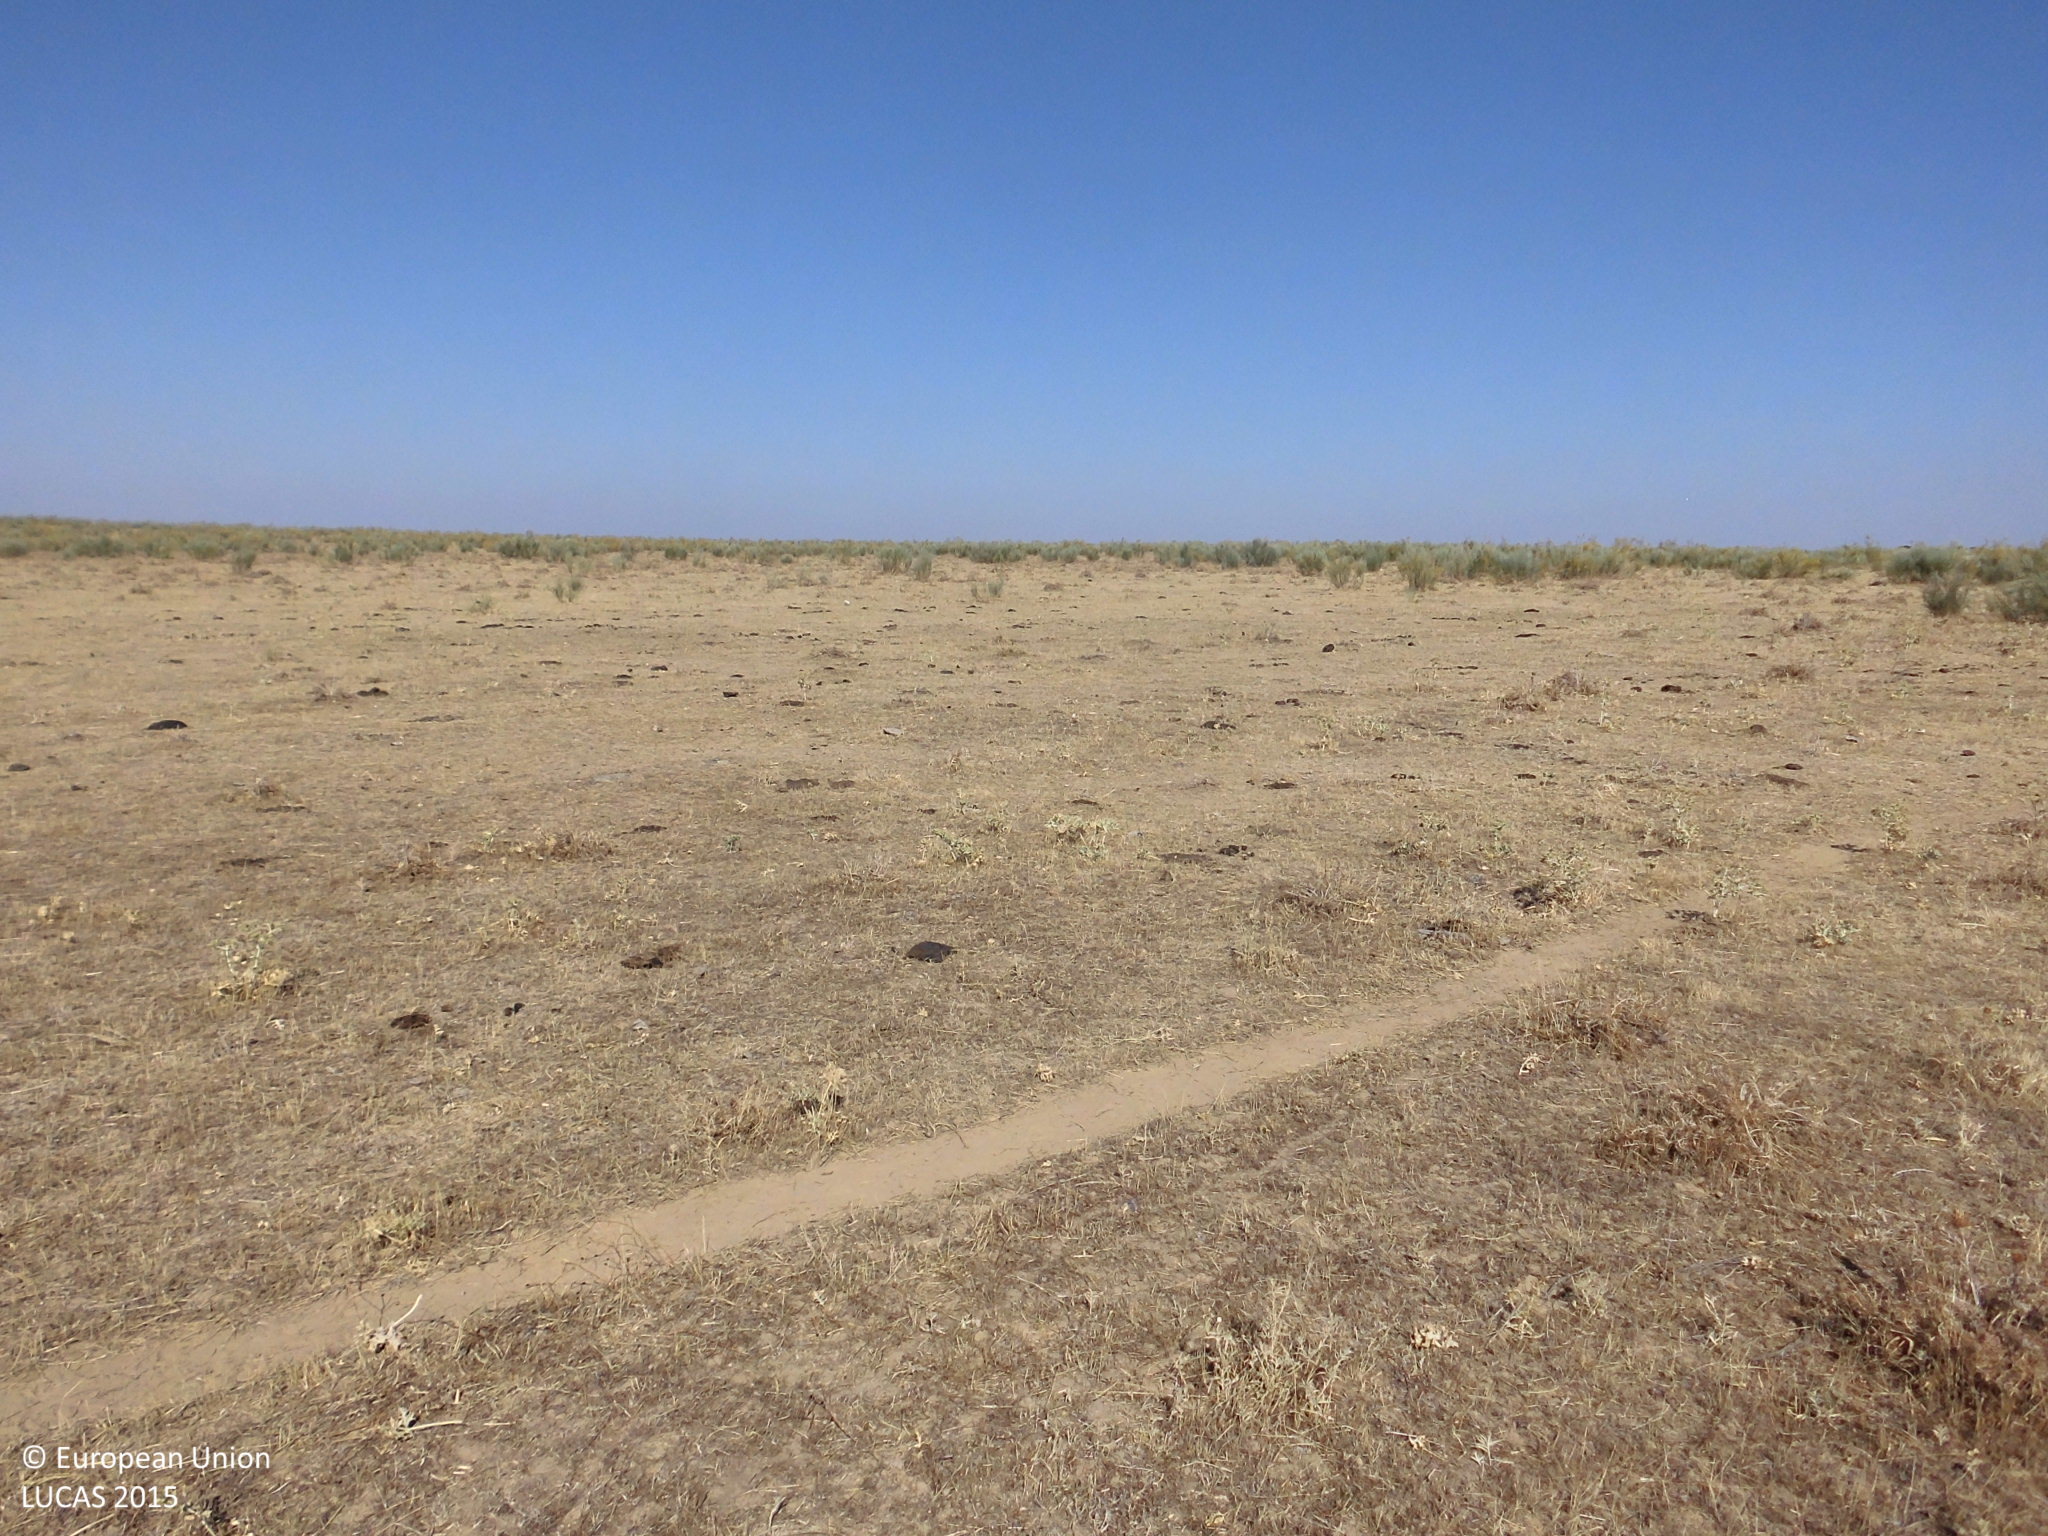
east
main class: Grassland
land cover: Grassland without tree/shrub cover
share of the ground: > 75 %
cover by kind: herbaceous plants 100 %
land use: Agriculture (excluding fallow land and kitchen gardens)
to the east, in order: Grassland without tree/shrub cover; Shrubland without tree cover
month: July
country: ES
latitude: 40.0403
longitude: -6.5959
